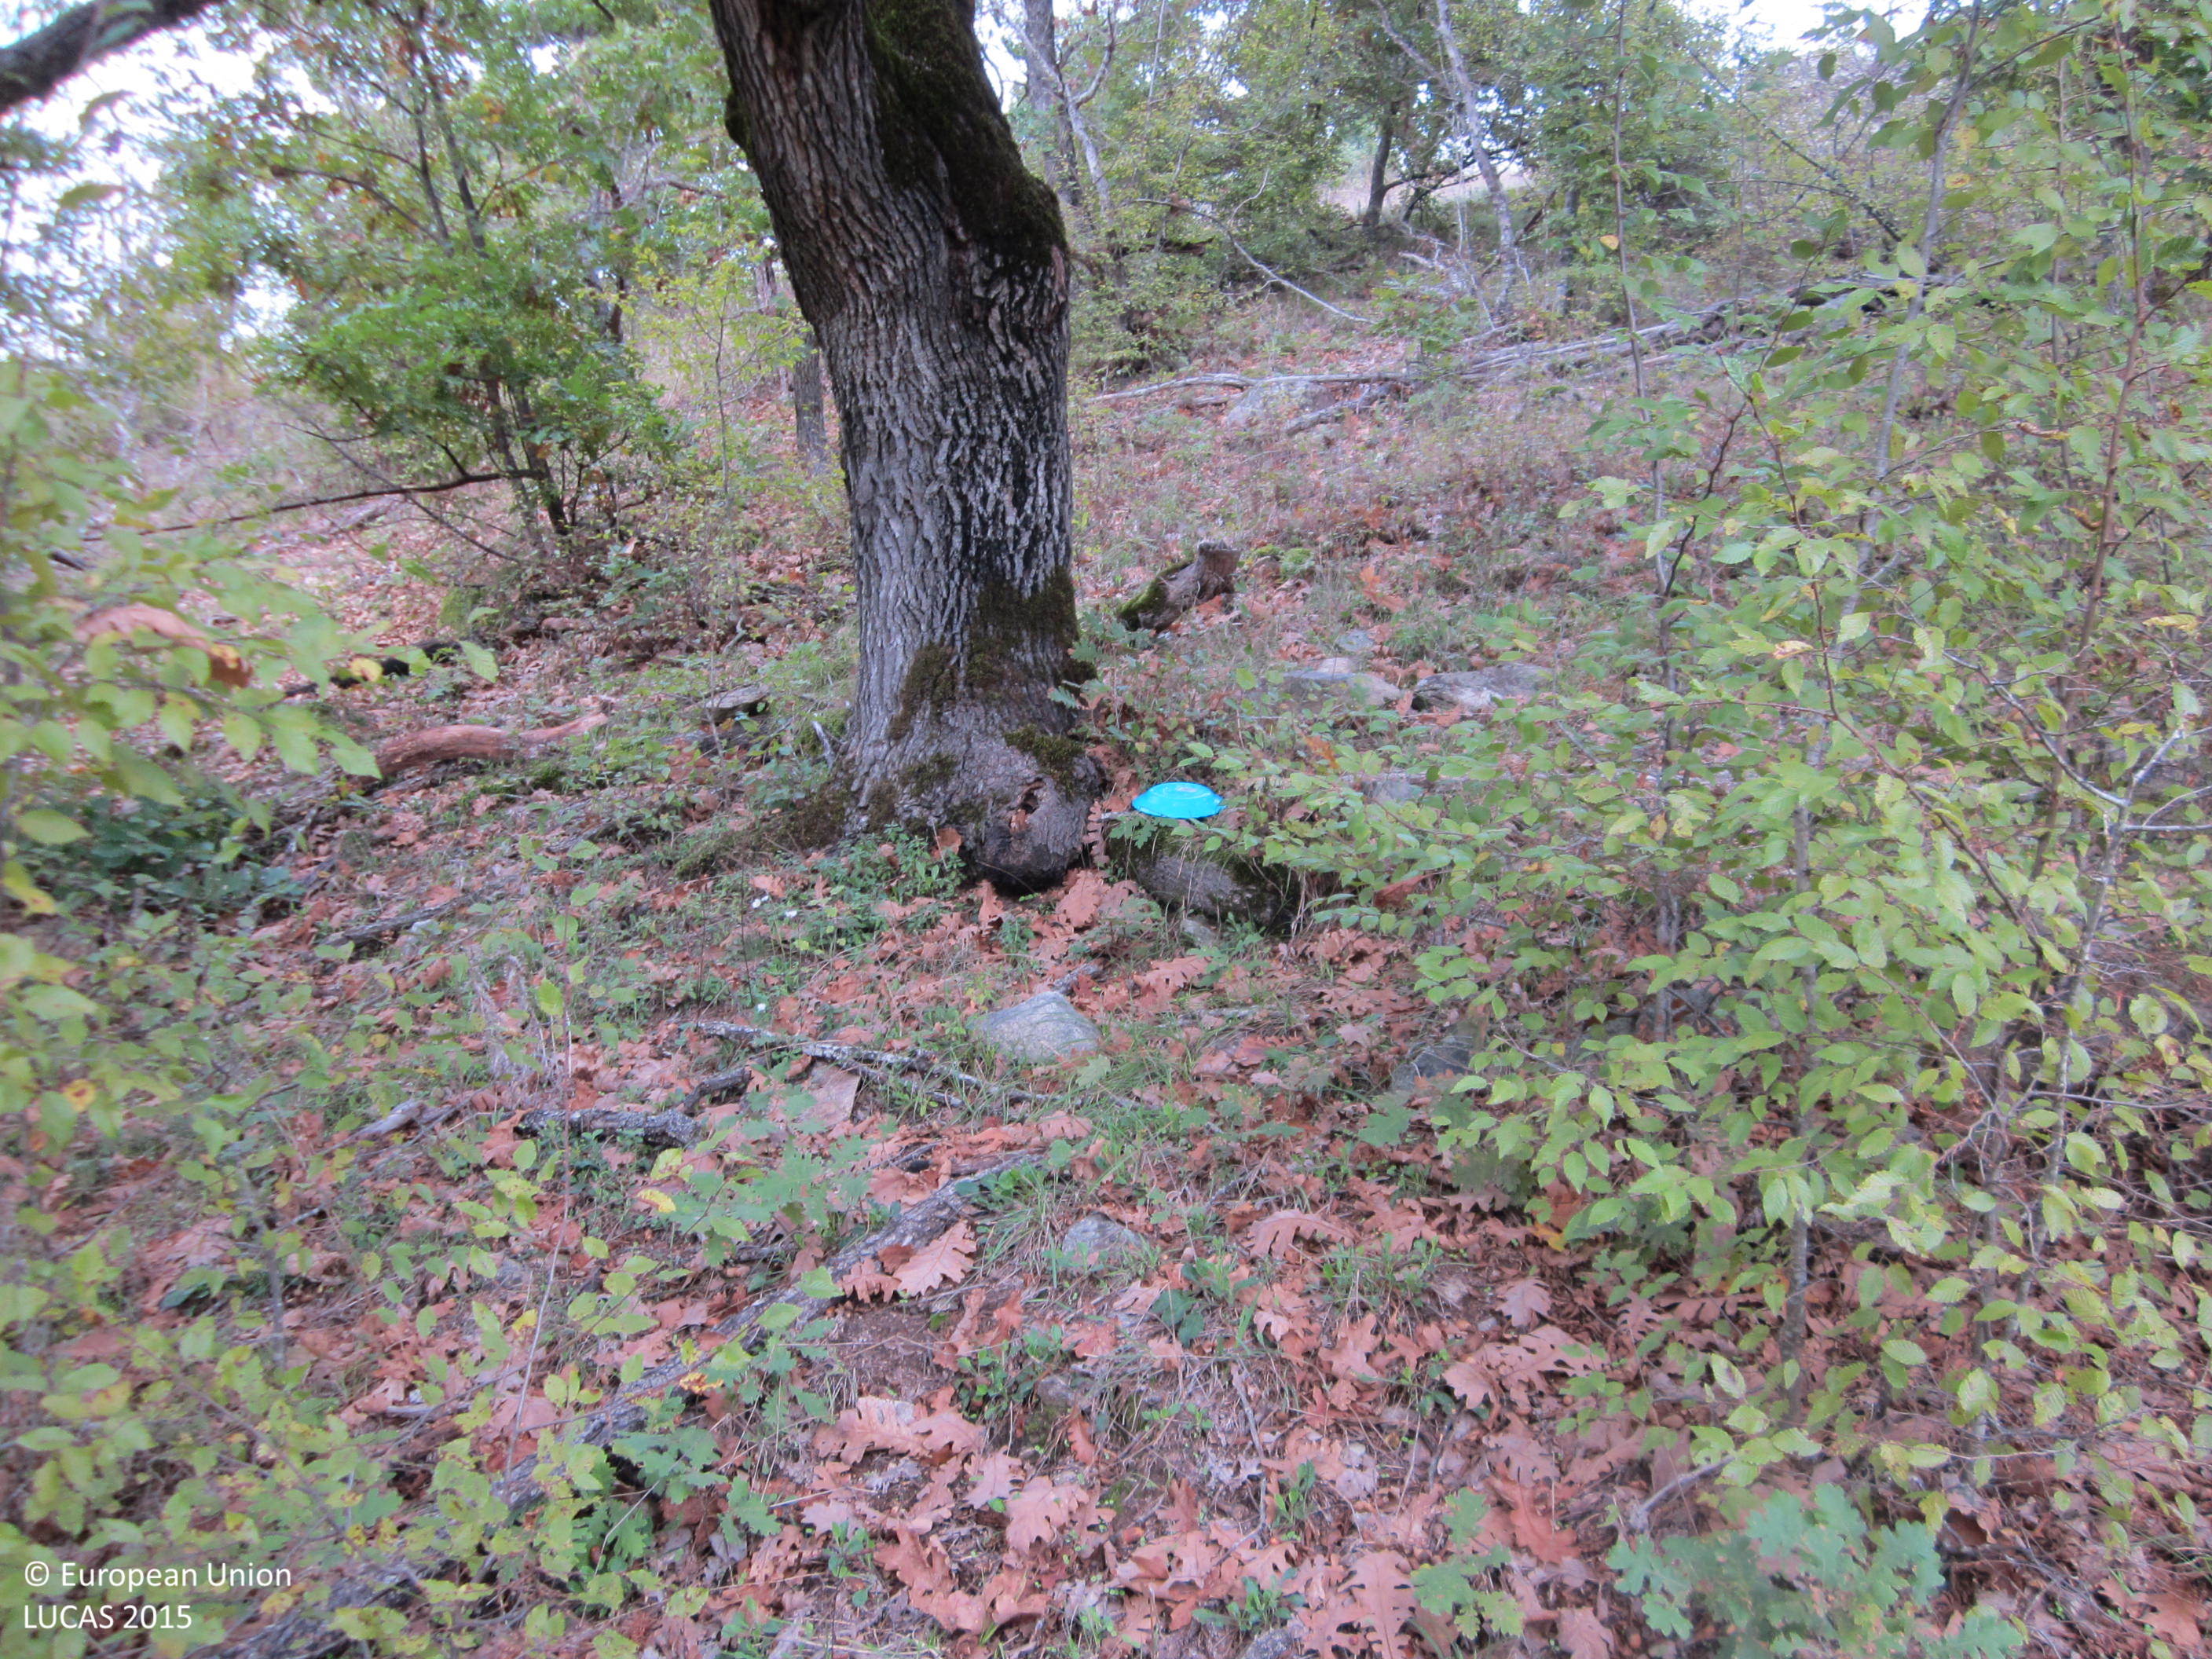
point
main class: Woodland
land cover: Broadleaved woodland
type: mesophytic deciduous forest
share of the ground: > 75 %
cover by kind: broadleaved forest trees 80 %, shrubs 10 %, herbaceous plants 10 %
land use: Forestry
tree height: > 5 m
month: October
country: BG
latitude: 42.2332
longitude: 27.2284
